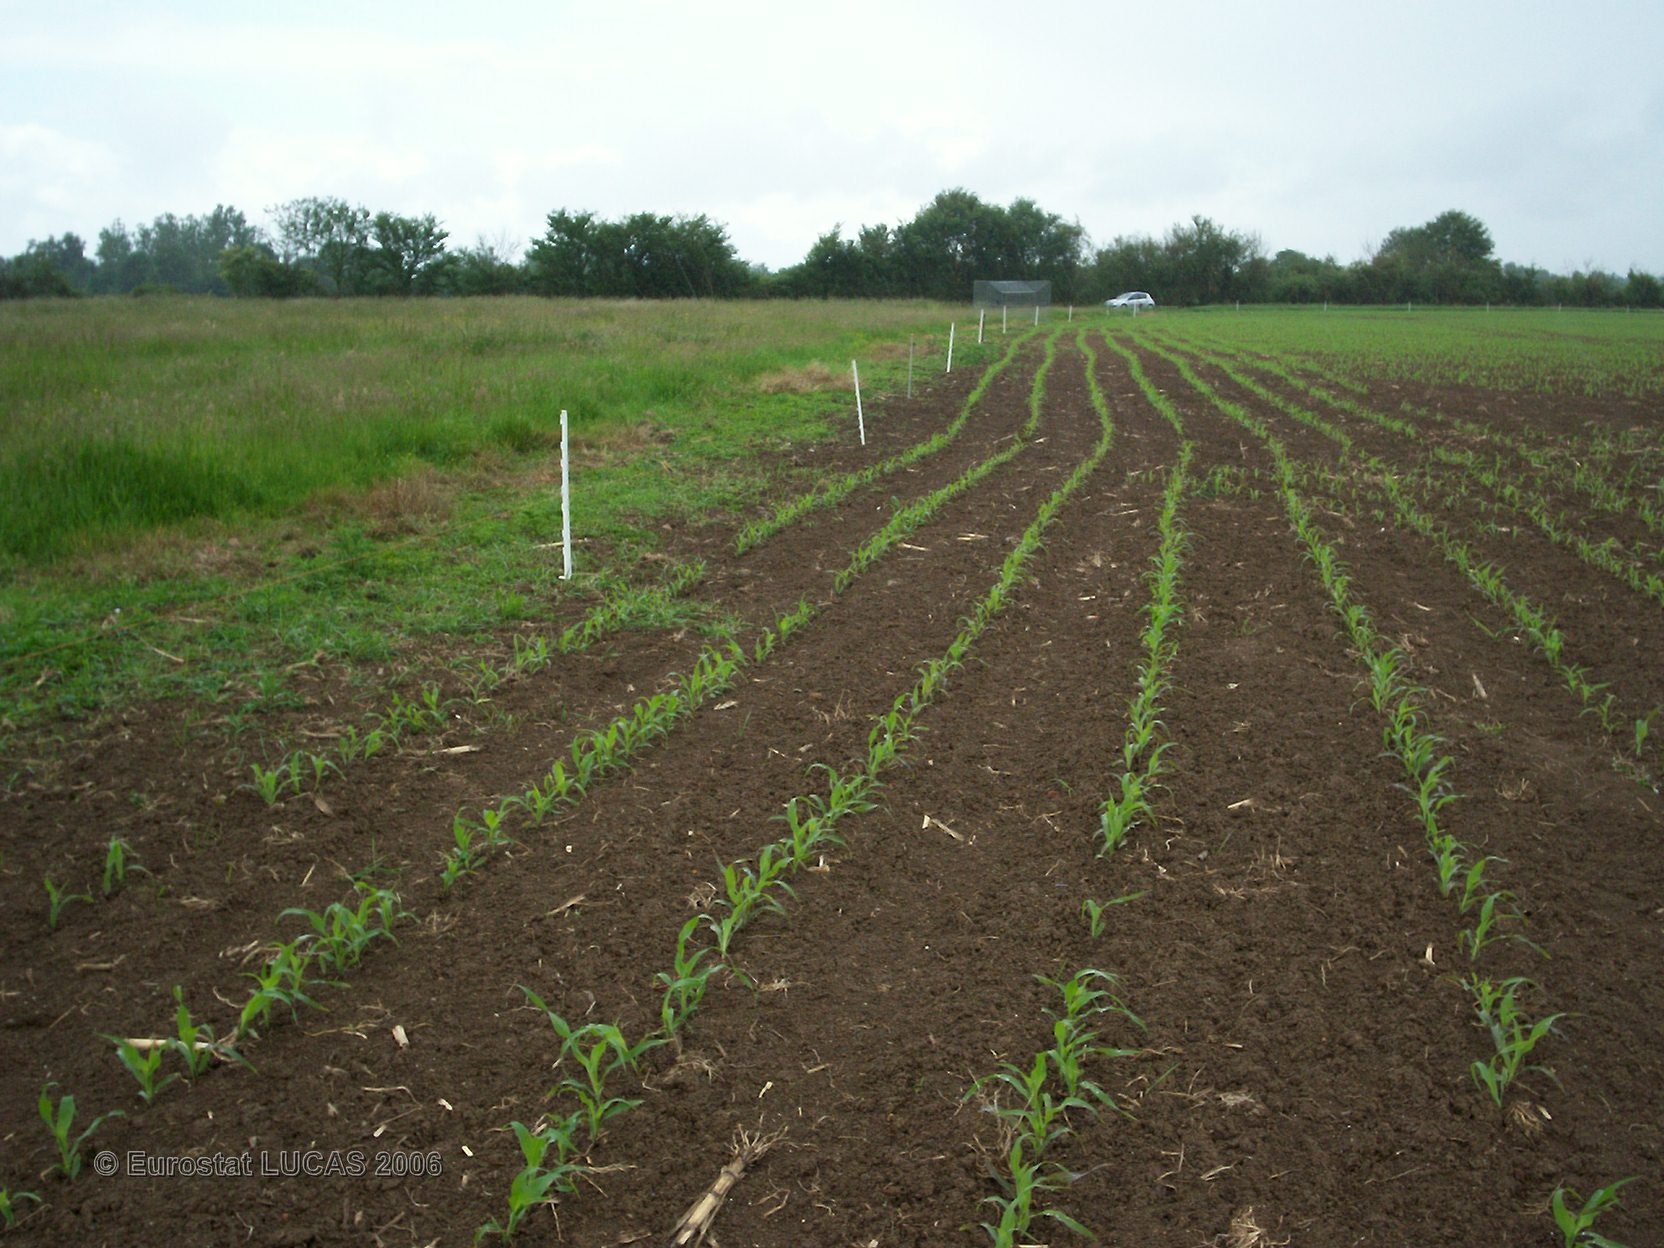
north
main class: Cropland
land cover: Maize
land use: Agriculture (excluding fallow land and kitchen gardens)
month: May
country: FR
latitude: 47.1872
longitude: 2.9874
